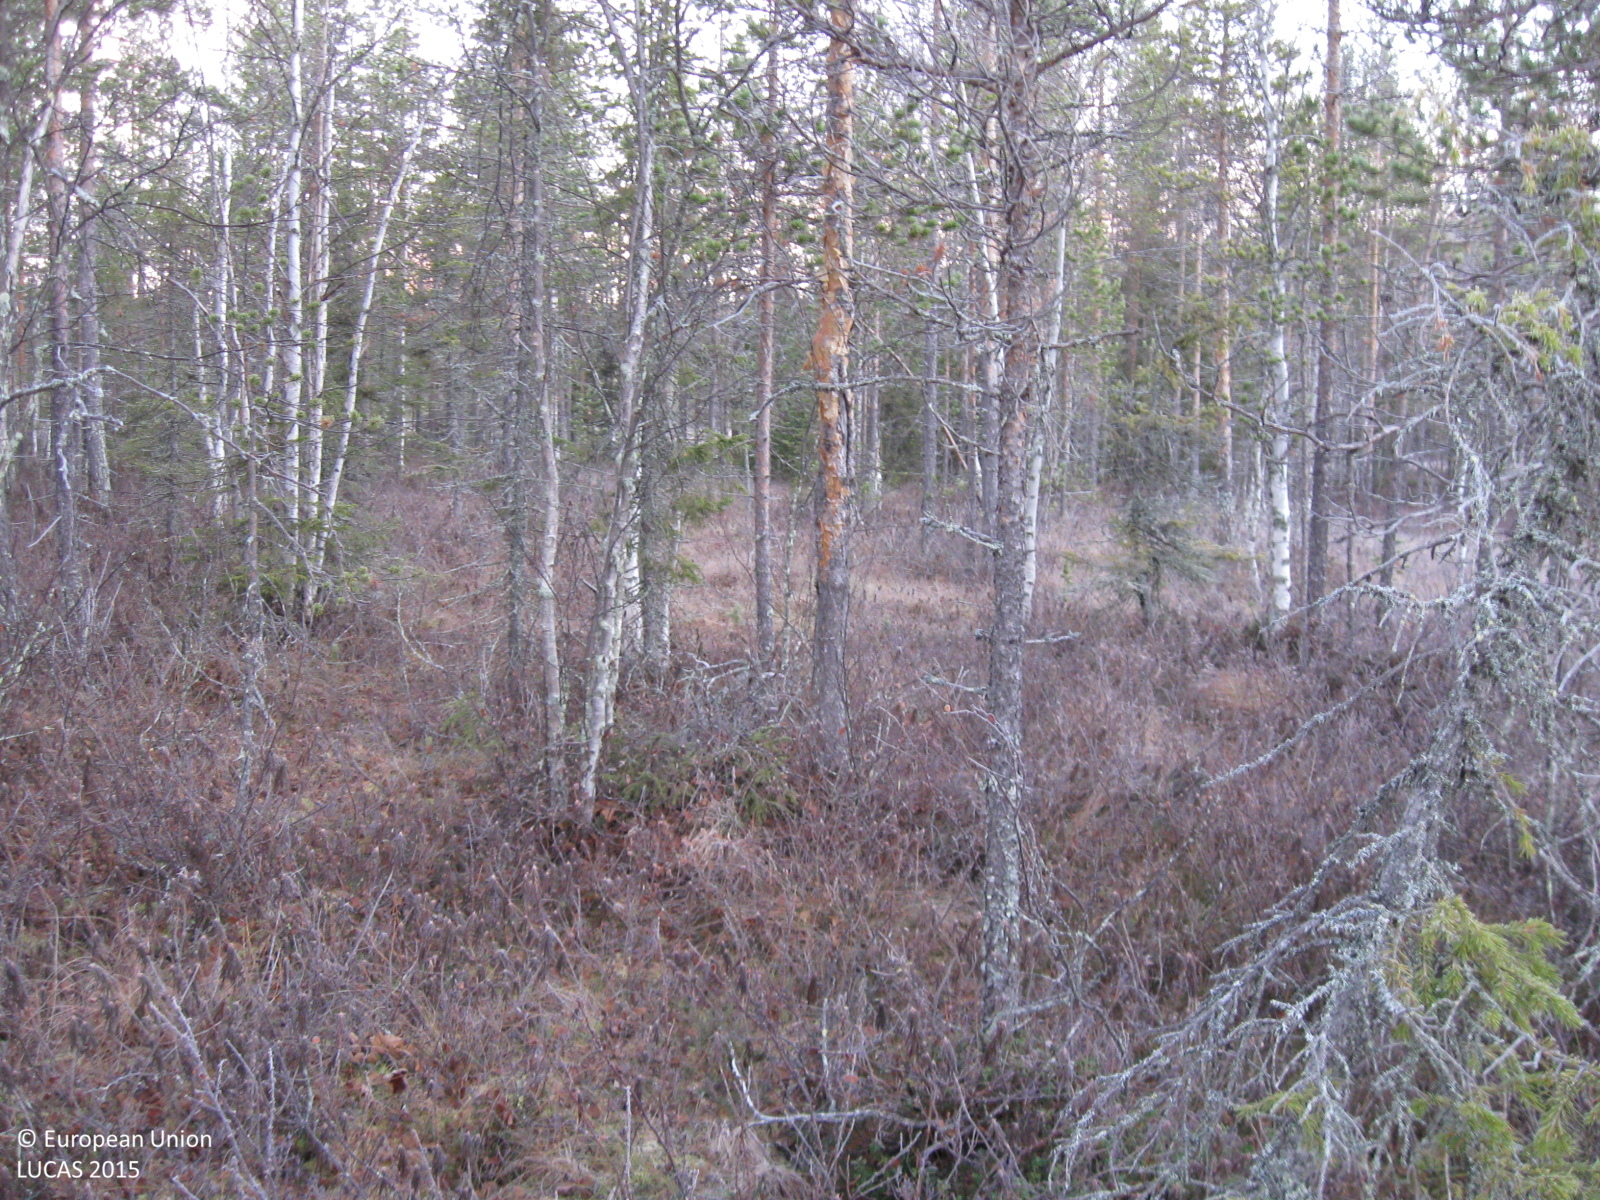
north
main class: Woodland
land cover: Pine dominated coniferous woodland
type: mire and swamp forests
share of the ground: 50 - 75 %
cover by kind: coniferous forest trees 45 %, shrubs 25 %, herbaceous plants 15 %, broadleaved forest trees 10 %, lichens and mosses 5 %
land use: Semi-natural and natural areas not in use
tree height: > 5 m
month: October
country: SE
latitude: 66.1488
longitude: 22.1397
